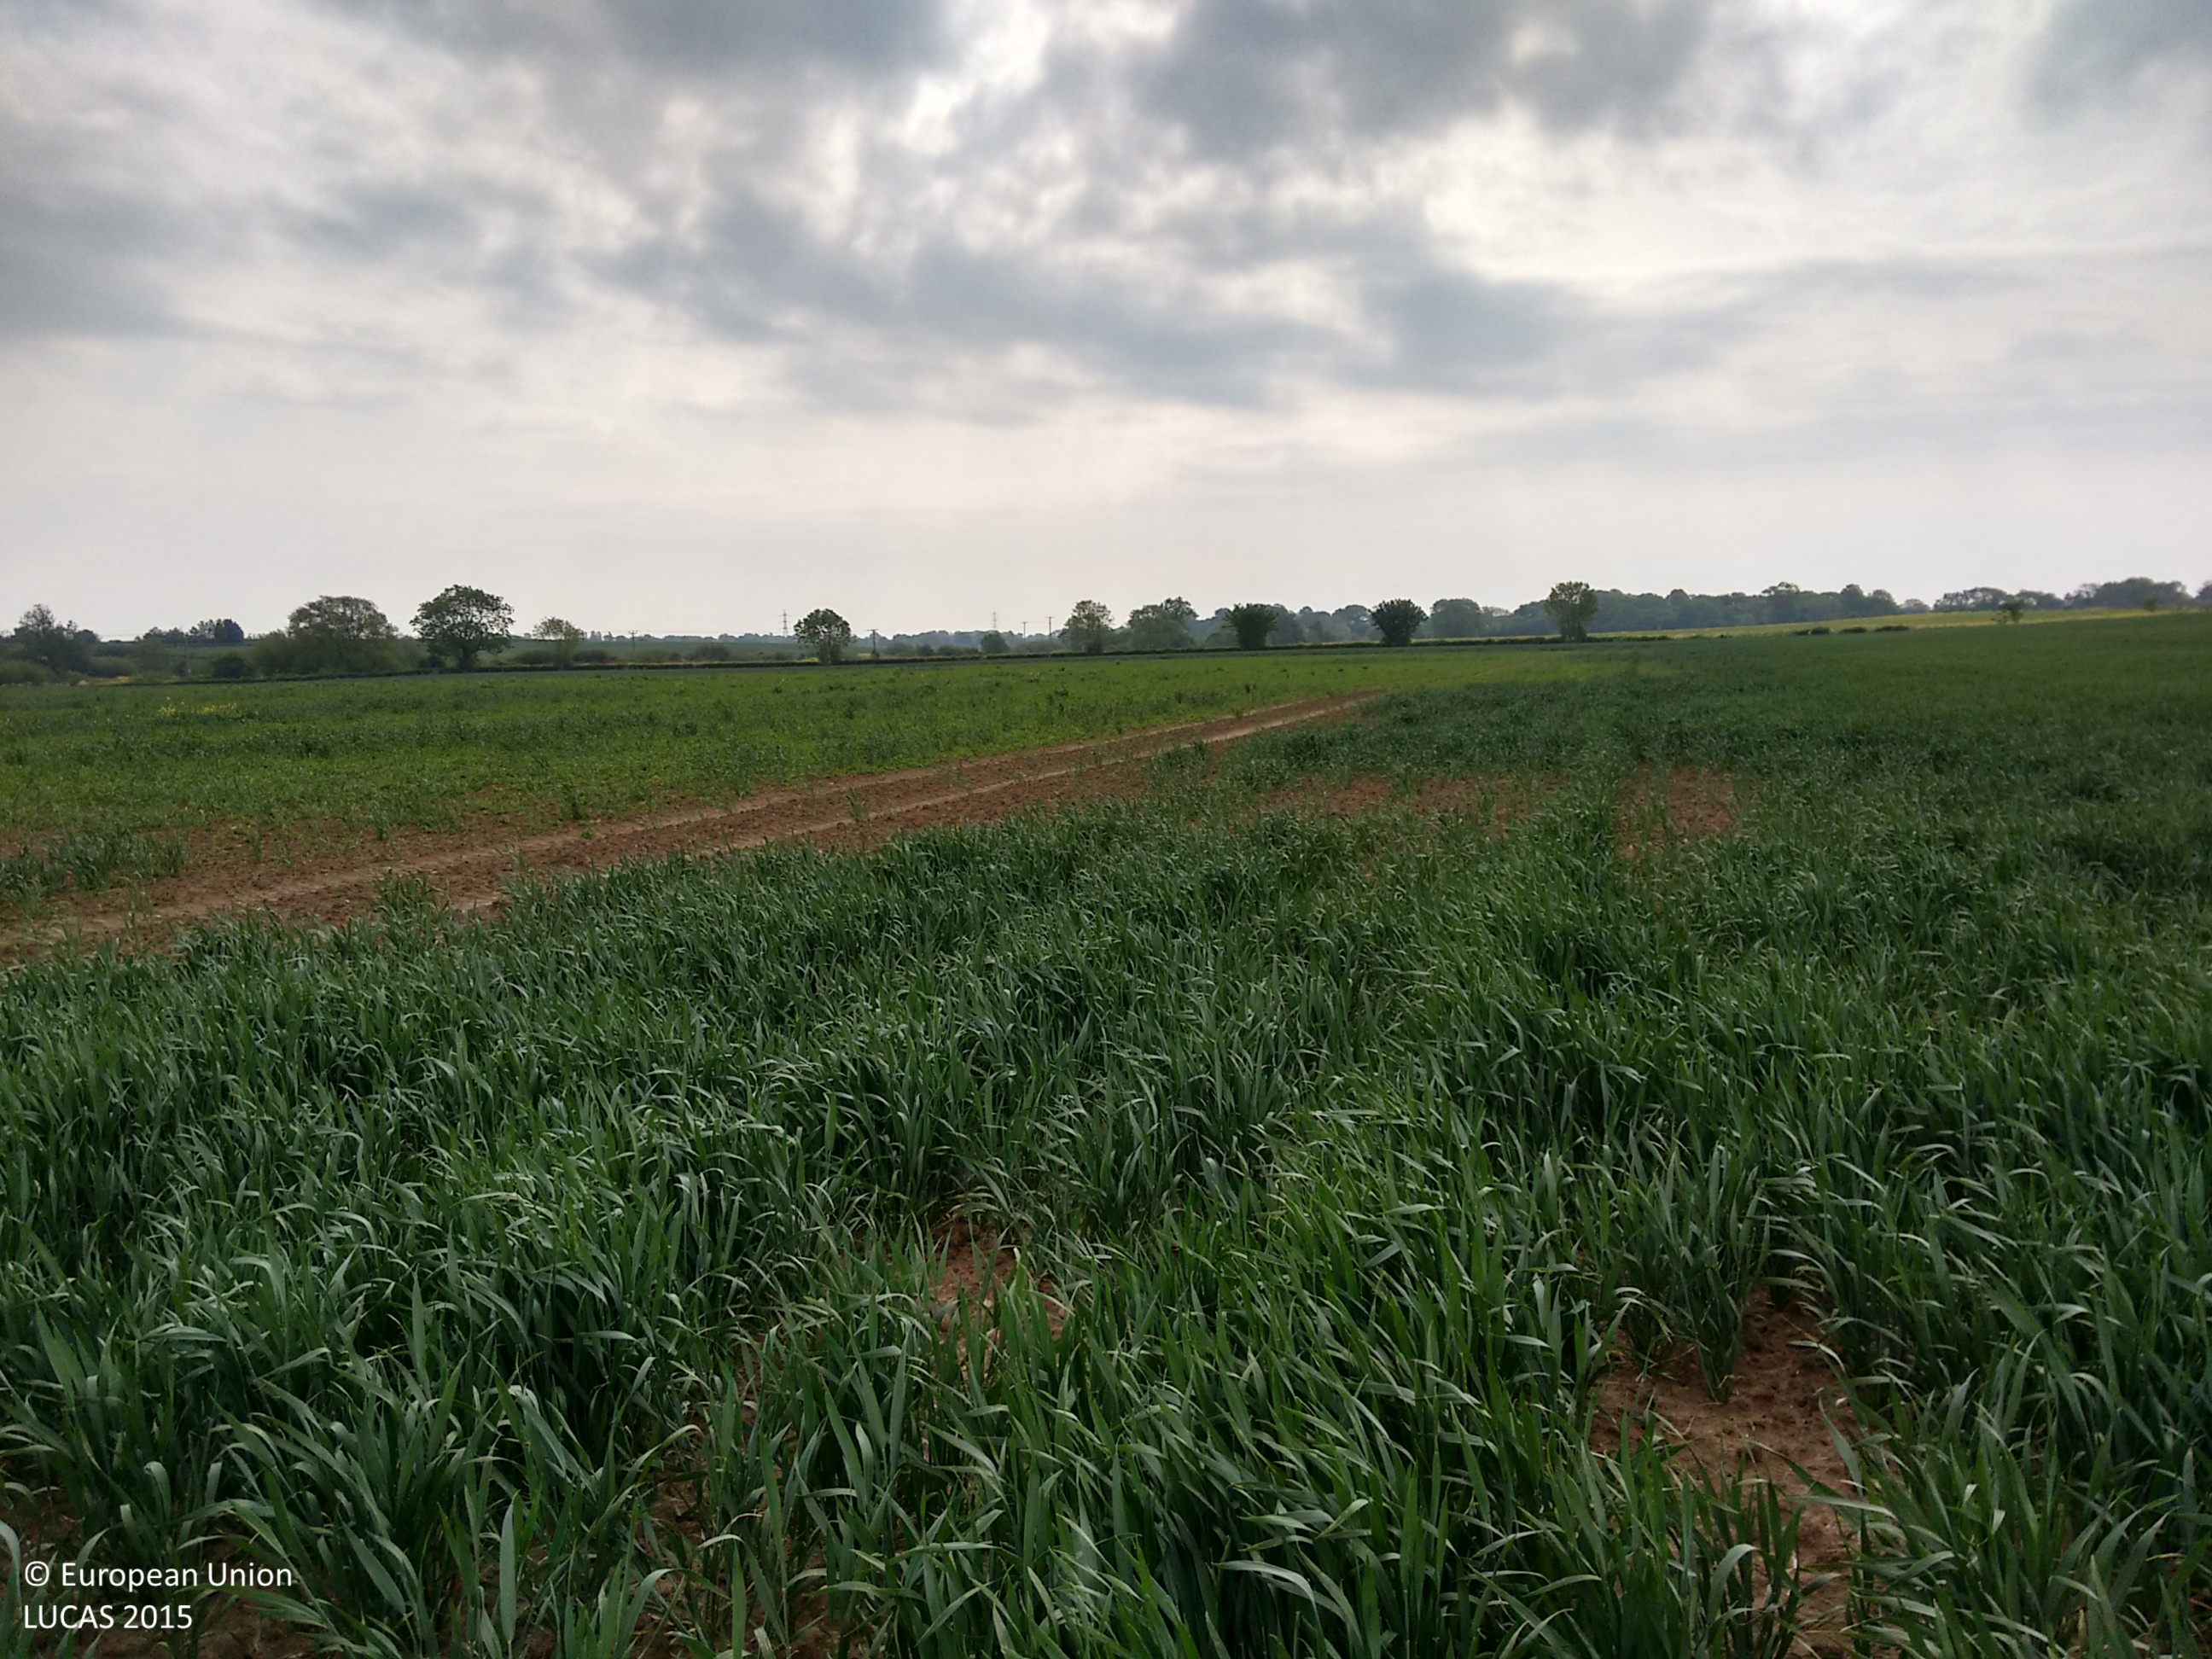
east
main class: Cropland
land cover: Common wheat
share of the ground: > 75 %
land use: Agriculture (excluding fallow land and kitchen gardens)
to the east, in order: Common wheat; Tracks; Grassland without tree/shrub cover; Common wheat
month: November
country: GB
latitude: 53.9915
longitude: -1.1639
